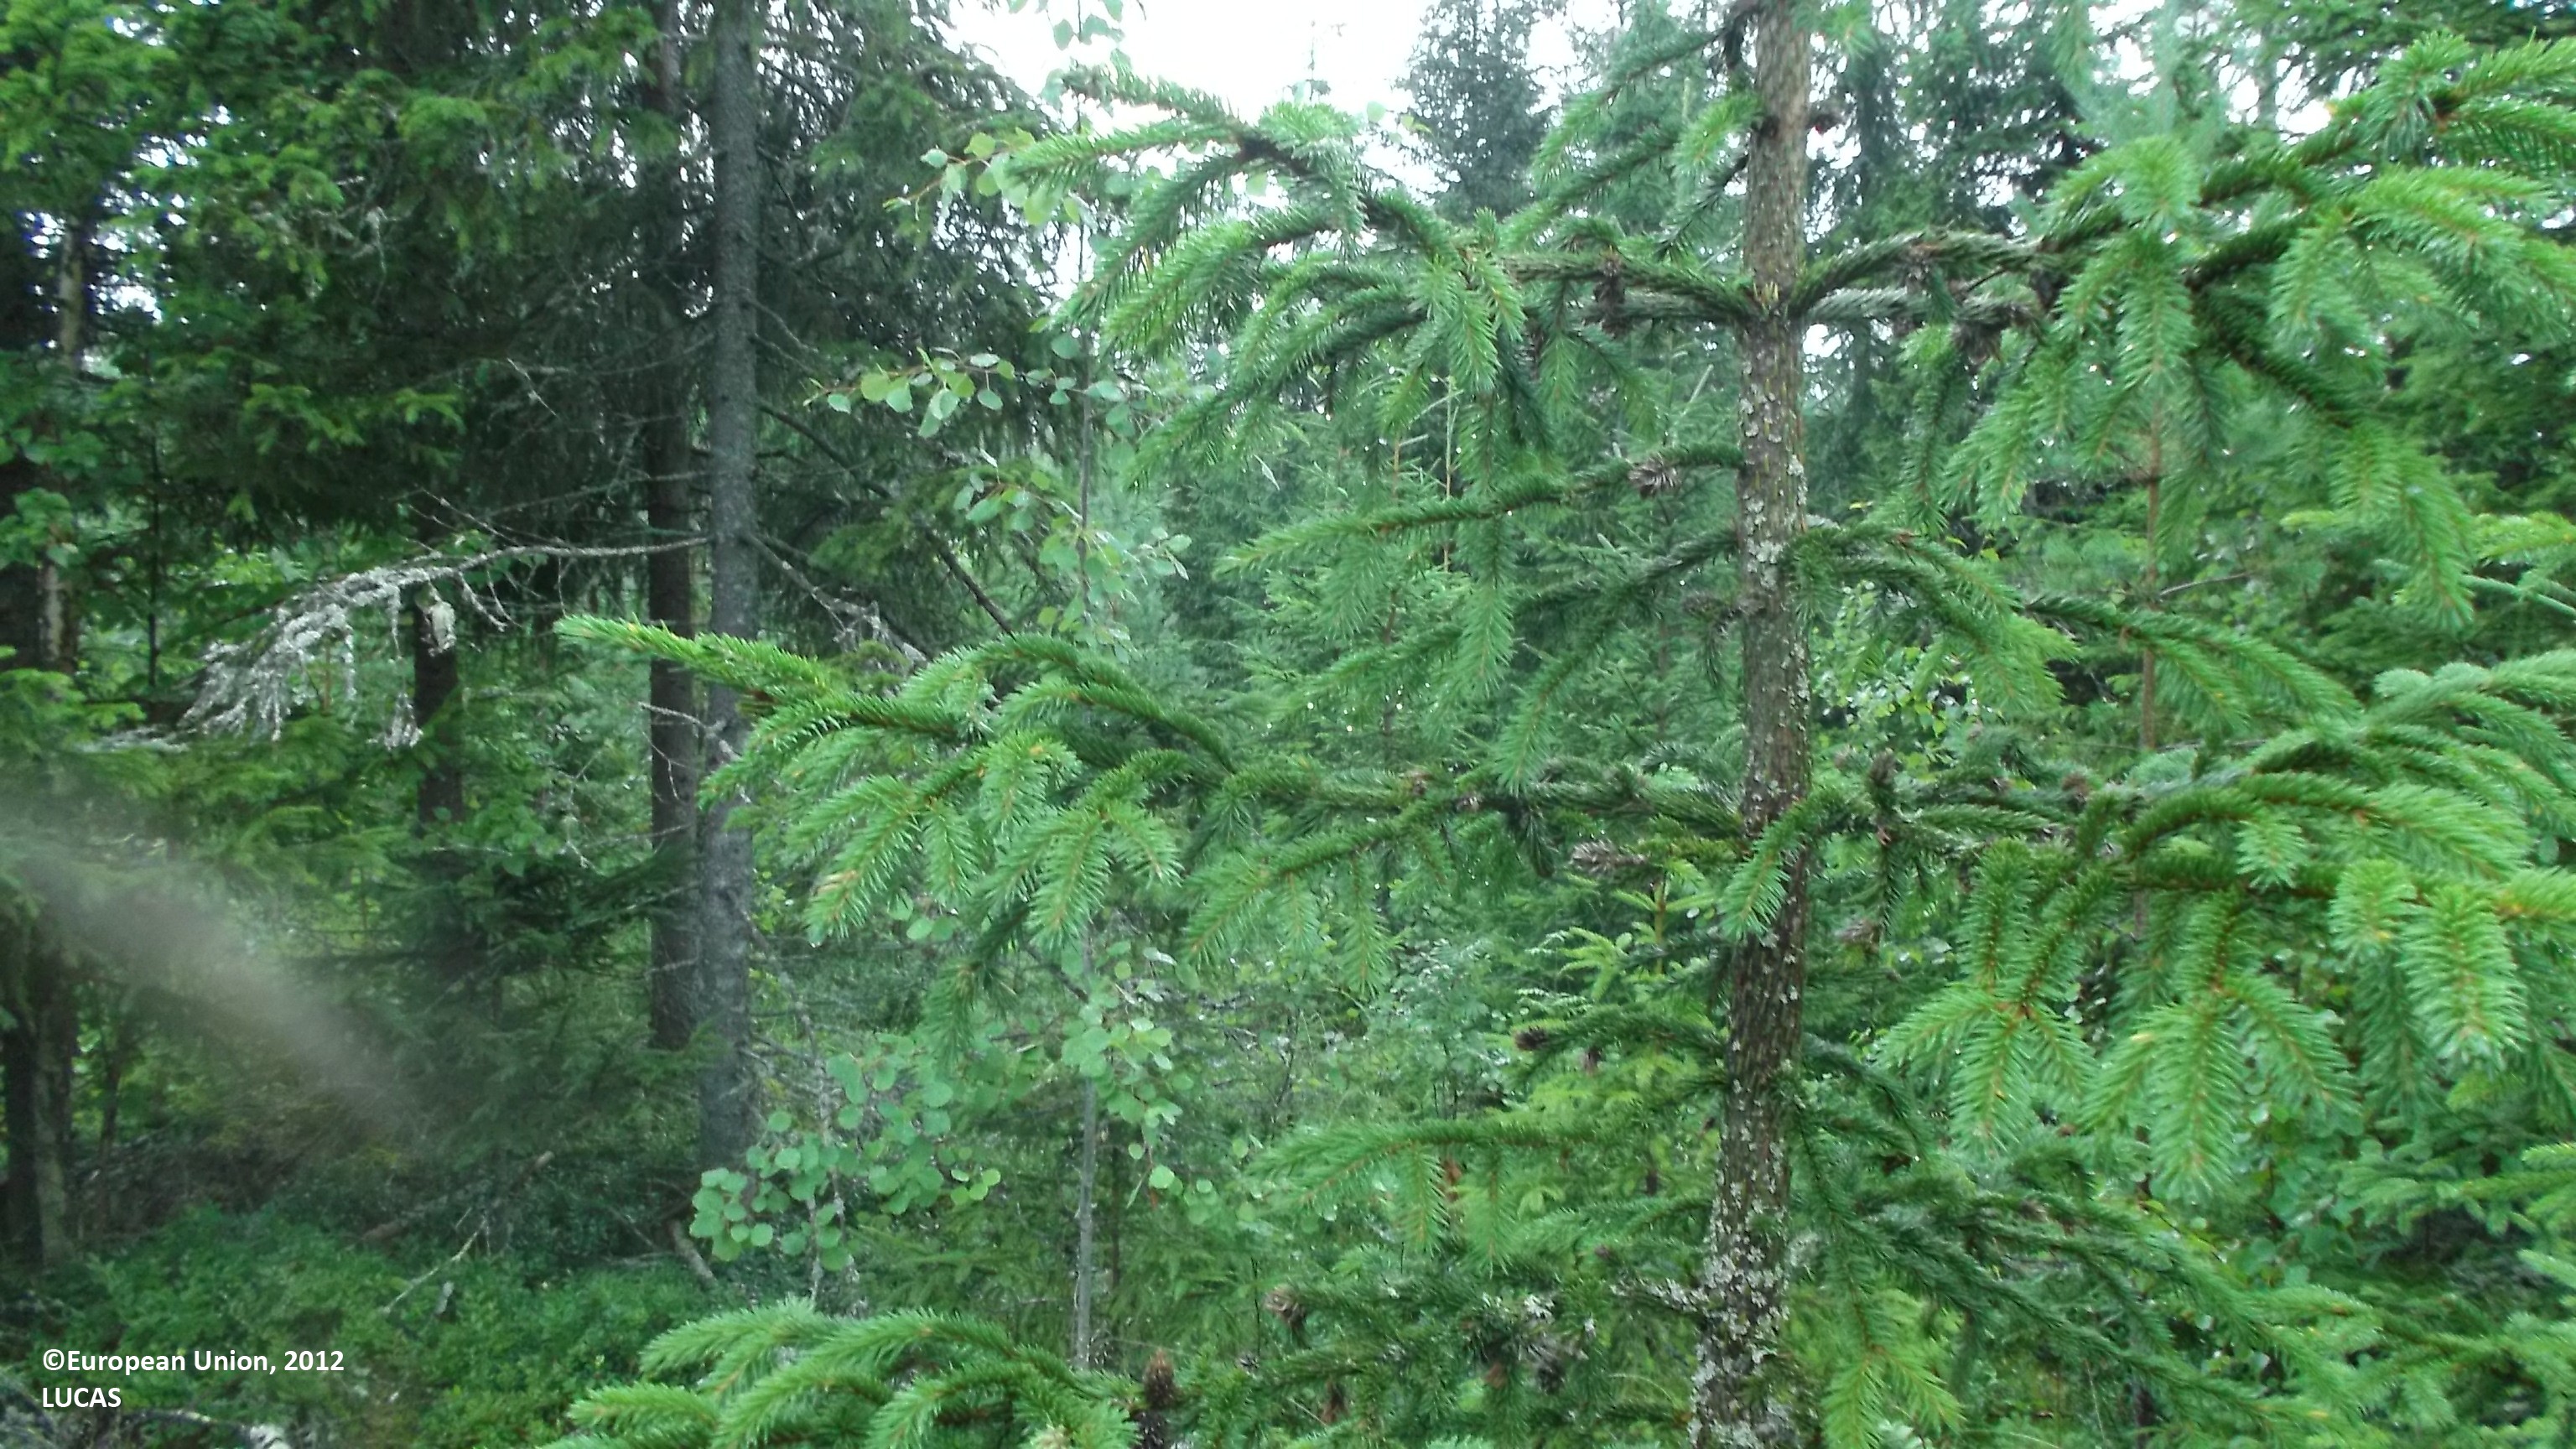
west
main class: Woodland
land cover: Other mixed woodland
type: boreal forest
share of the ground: 50 - 75 %
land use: Forestry
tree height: > 5 m
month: August
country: FI
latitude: 63.7362
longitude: 22.9539
